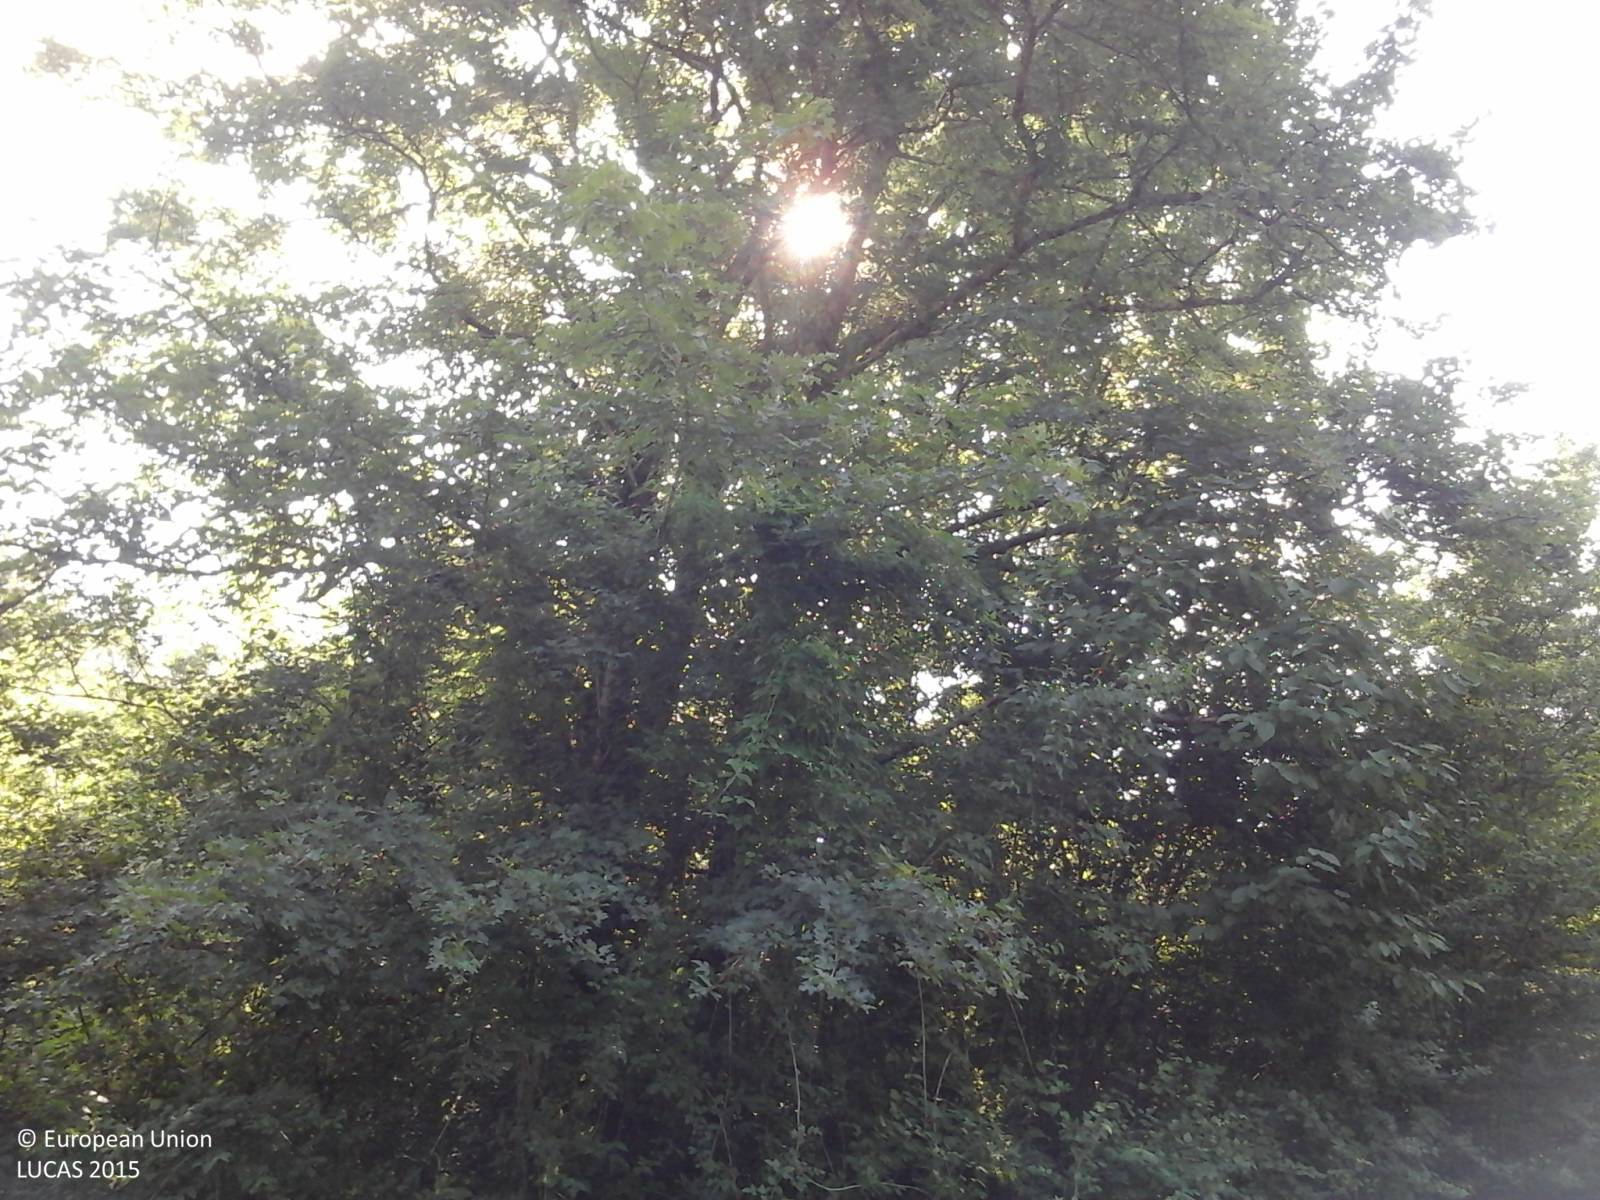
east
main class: Woodland
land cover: Broadleaved woodland
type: thermophilous deciduous forest
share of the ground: > 75 %
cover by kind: broadleaved forest trees 70 %, shrubs 30 %
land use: Forestry
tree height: < 5 m
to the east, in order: Broadleaved woodland; Tracks; Fences; Arable land (only in case pi); Fences; Broadleaved woodland; Electric lines; Broadleaved woodland; Paved roads, cycling and walking lanes; Fences; Grassland without tree/shrub cover
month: June
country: IT
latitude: 44.0241
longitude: 10.6098
